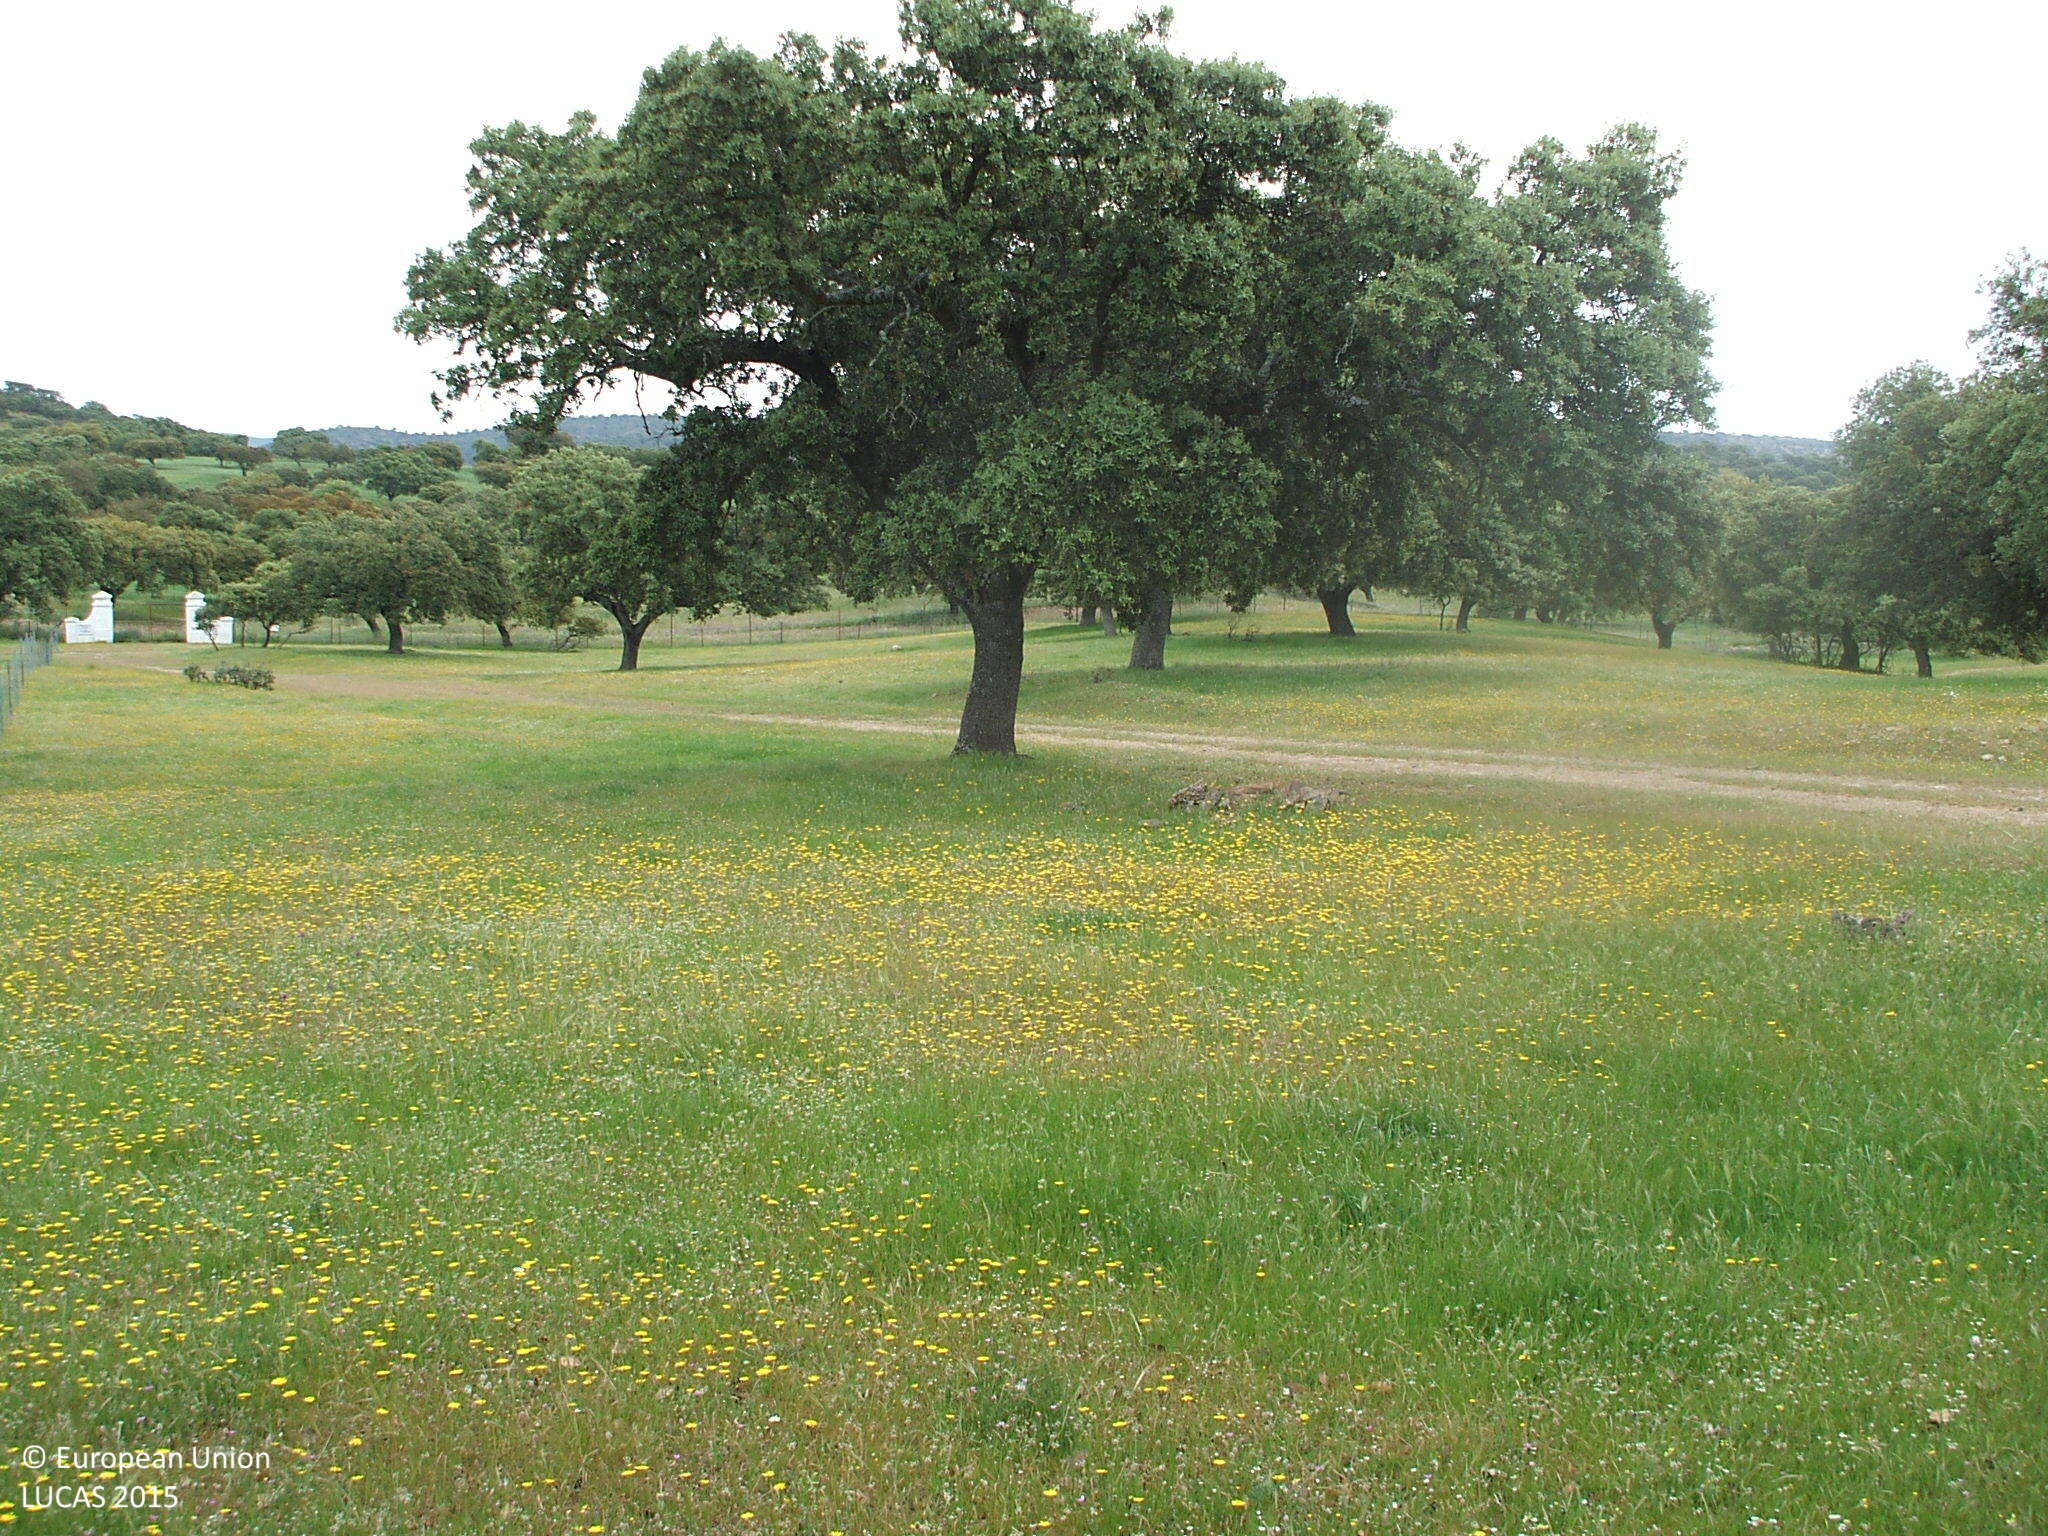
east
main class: Woodland
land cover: Broadleaved woodland
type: broadleaved evergreen forest
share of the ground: 10 - 25 %
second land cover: Grassland without tree/shrub cover
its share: > 75 %
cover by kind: herbaceous plants 80 %, broadleaved forest trees 20 %
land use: Forestry
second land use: Agriculture (excluding fallow land and kitchen gardens)
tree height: > 5 m
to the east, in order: Broadleaved woodland; Grassland without tree/shrub cover; Tracks; Broadleaved woodland; Tracks; Broadleaved woodland; Fences; Broadleaved woodland; Tracks; Grassland without tree/shrub cover
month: April
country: ES
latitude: 38.1722
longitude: -5.7753
